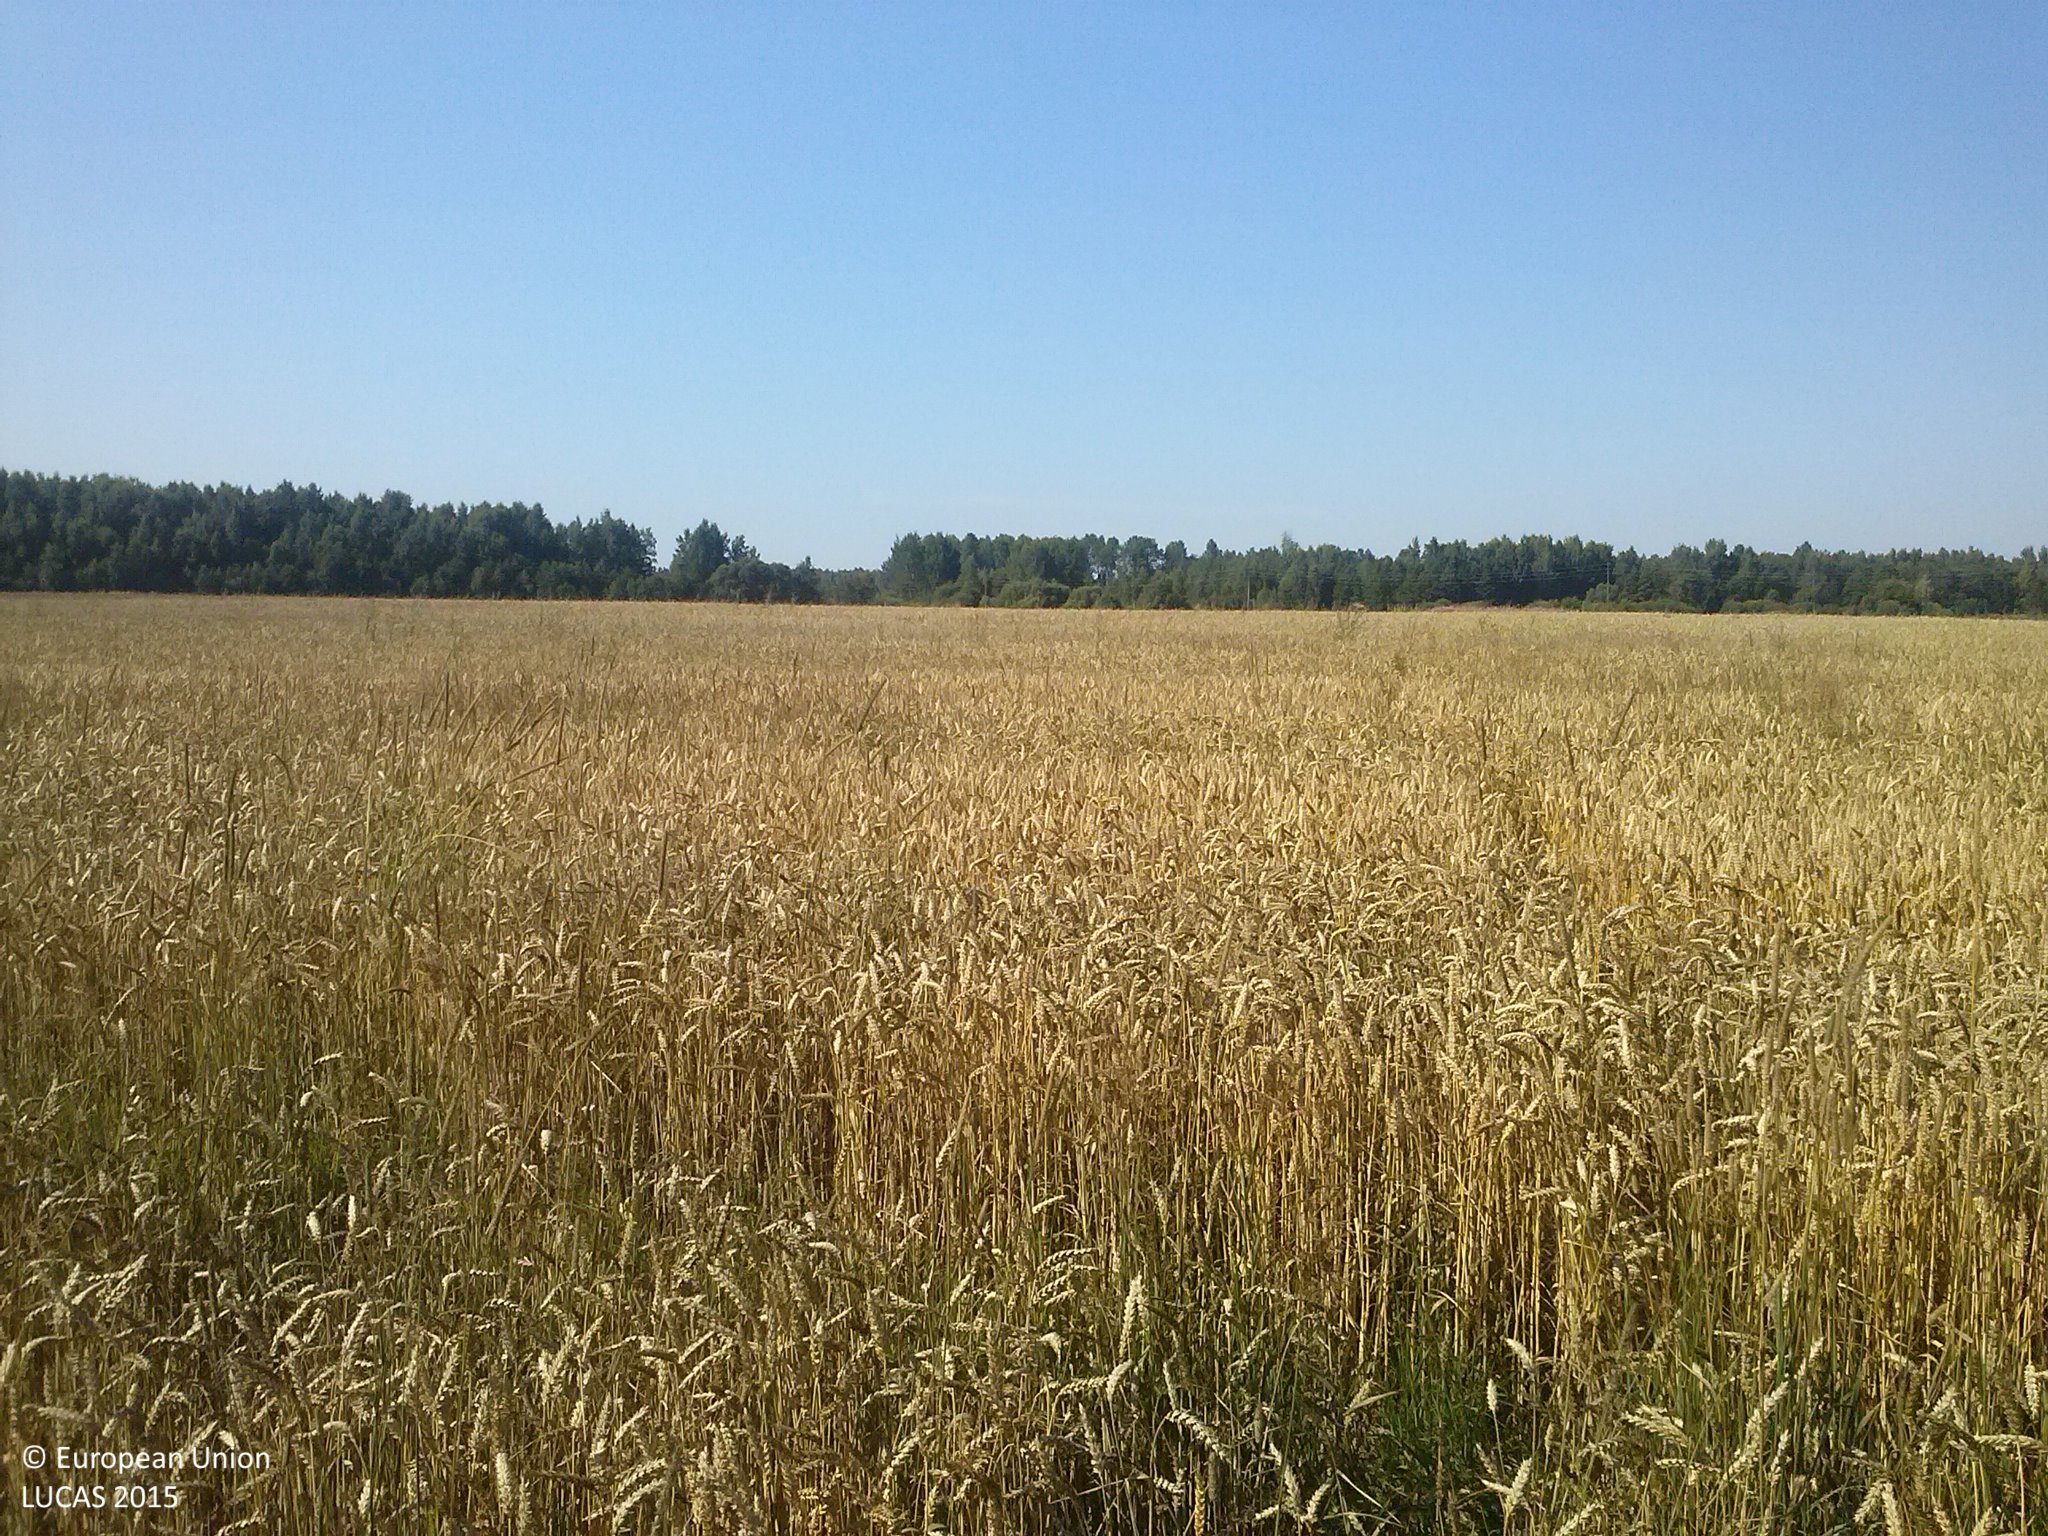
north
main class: Cropland
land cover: Common wheat
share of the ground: > 75 %
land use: Agriculture (excluding fallow land and kitchen gardens)
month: August
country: LV
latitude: 56.6998
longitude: 27.8103
